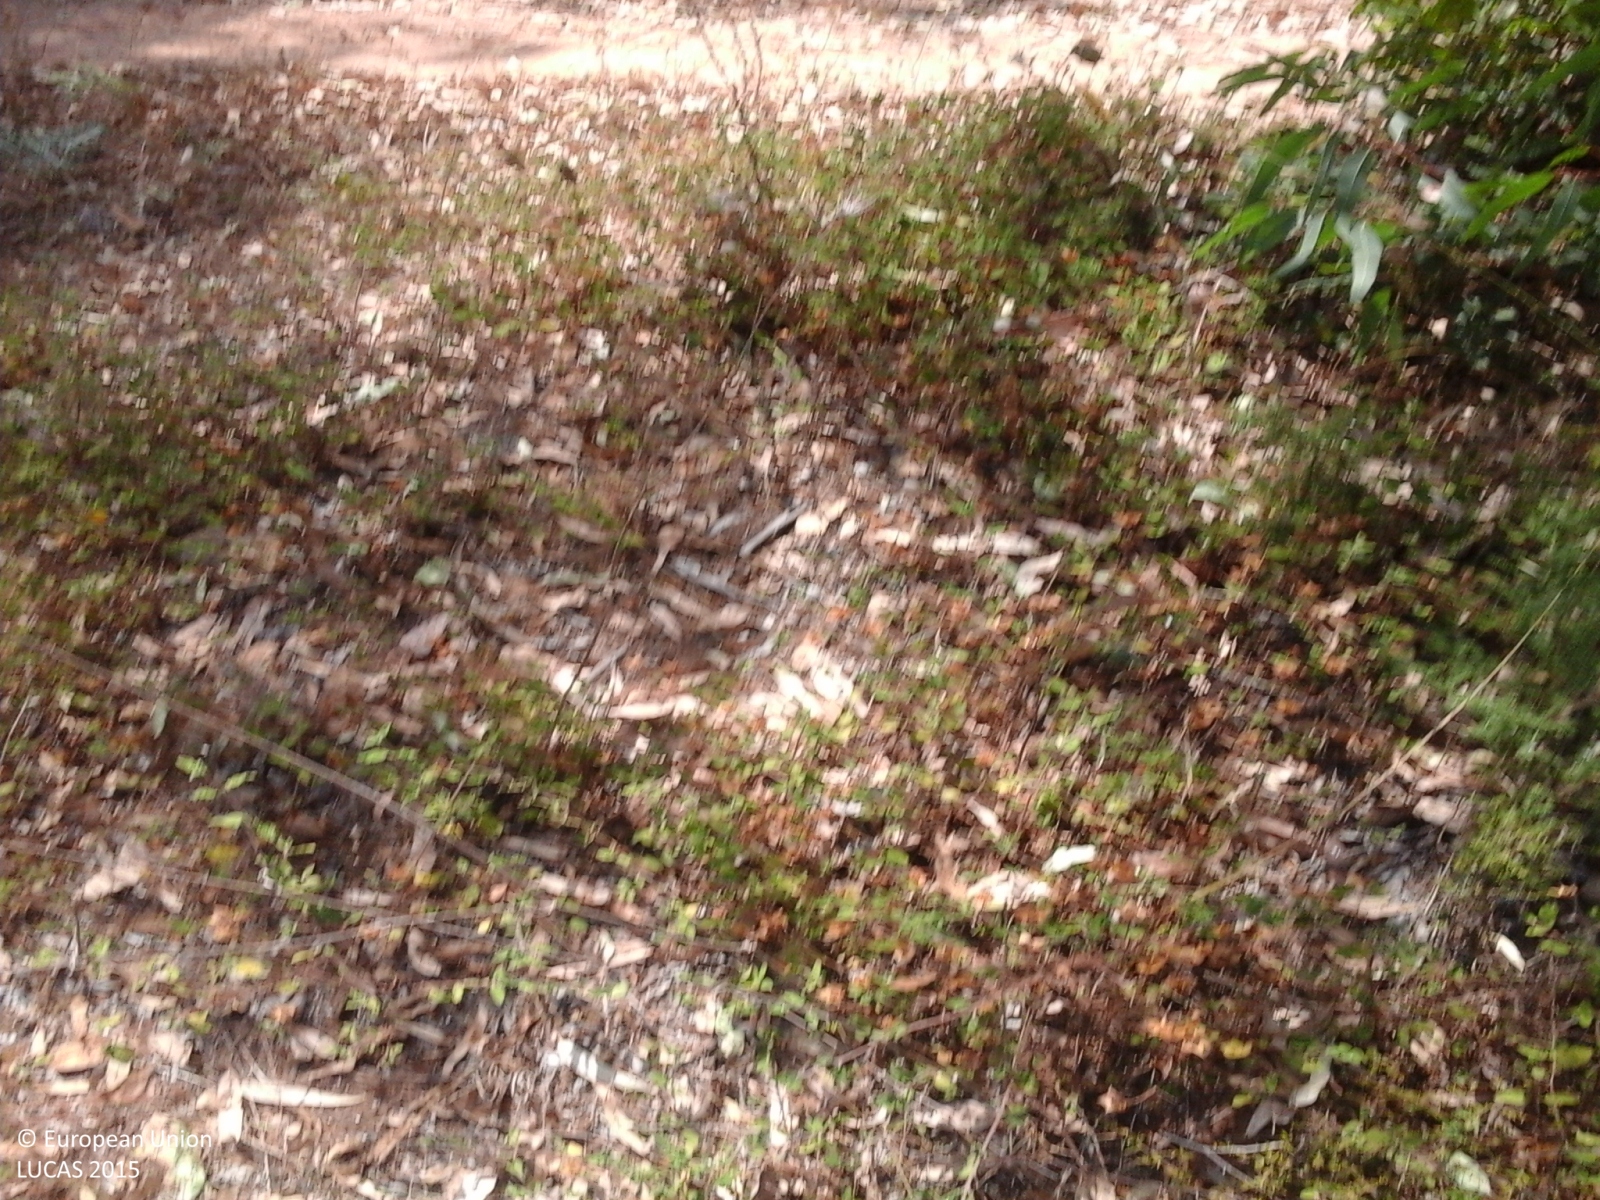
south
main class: Woodland
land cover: Broadleaved woodland
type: broadleaved evergreen forest
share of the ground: > 75 %
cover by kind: broadleaved forest trees 100 %
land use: Forestry
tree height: > 5 m
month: July
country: IT
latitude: 37.2660
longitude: 14.3532
